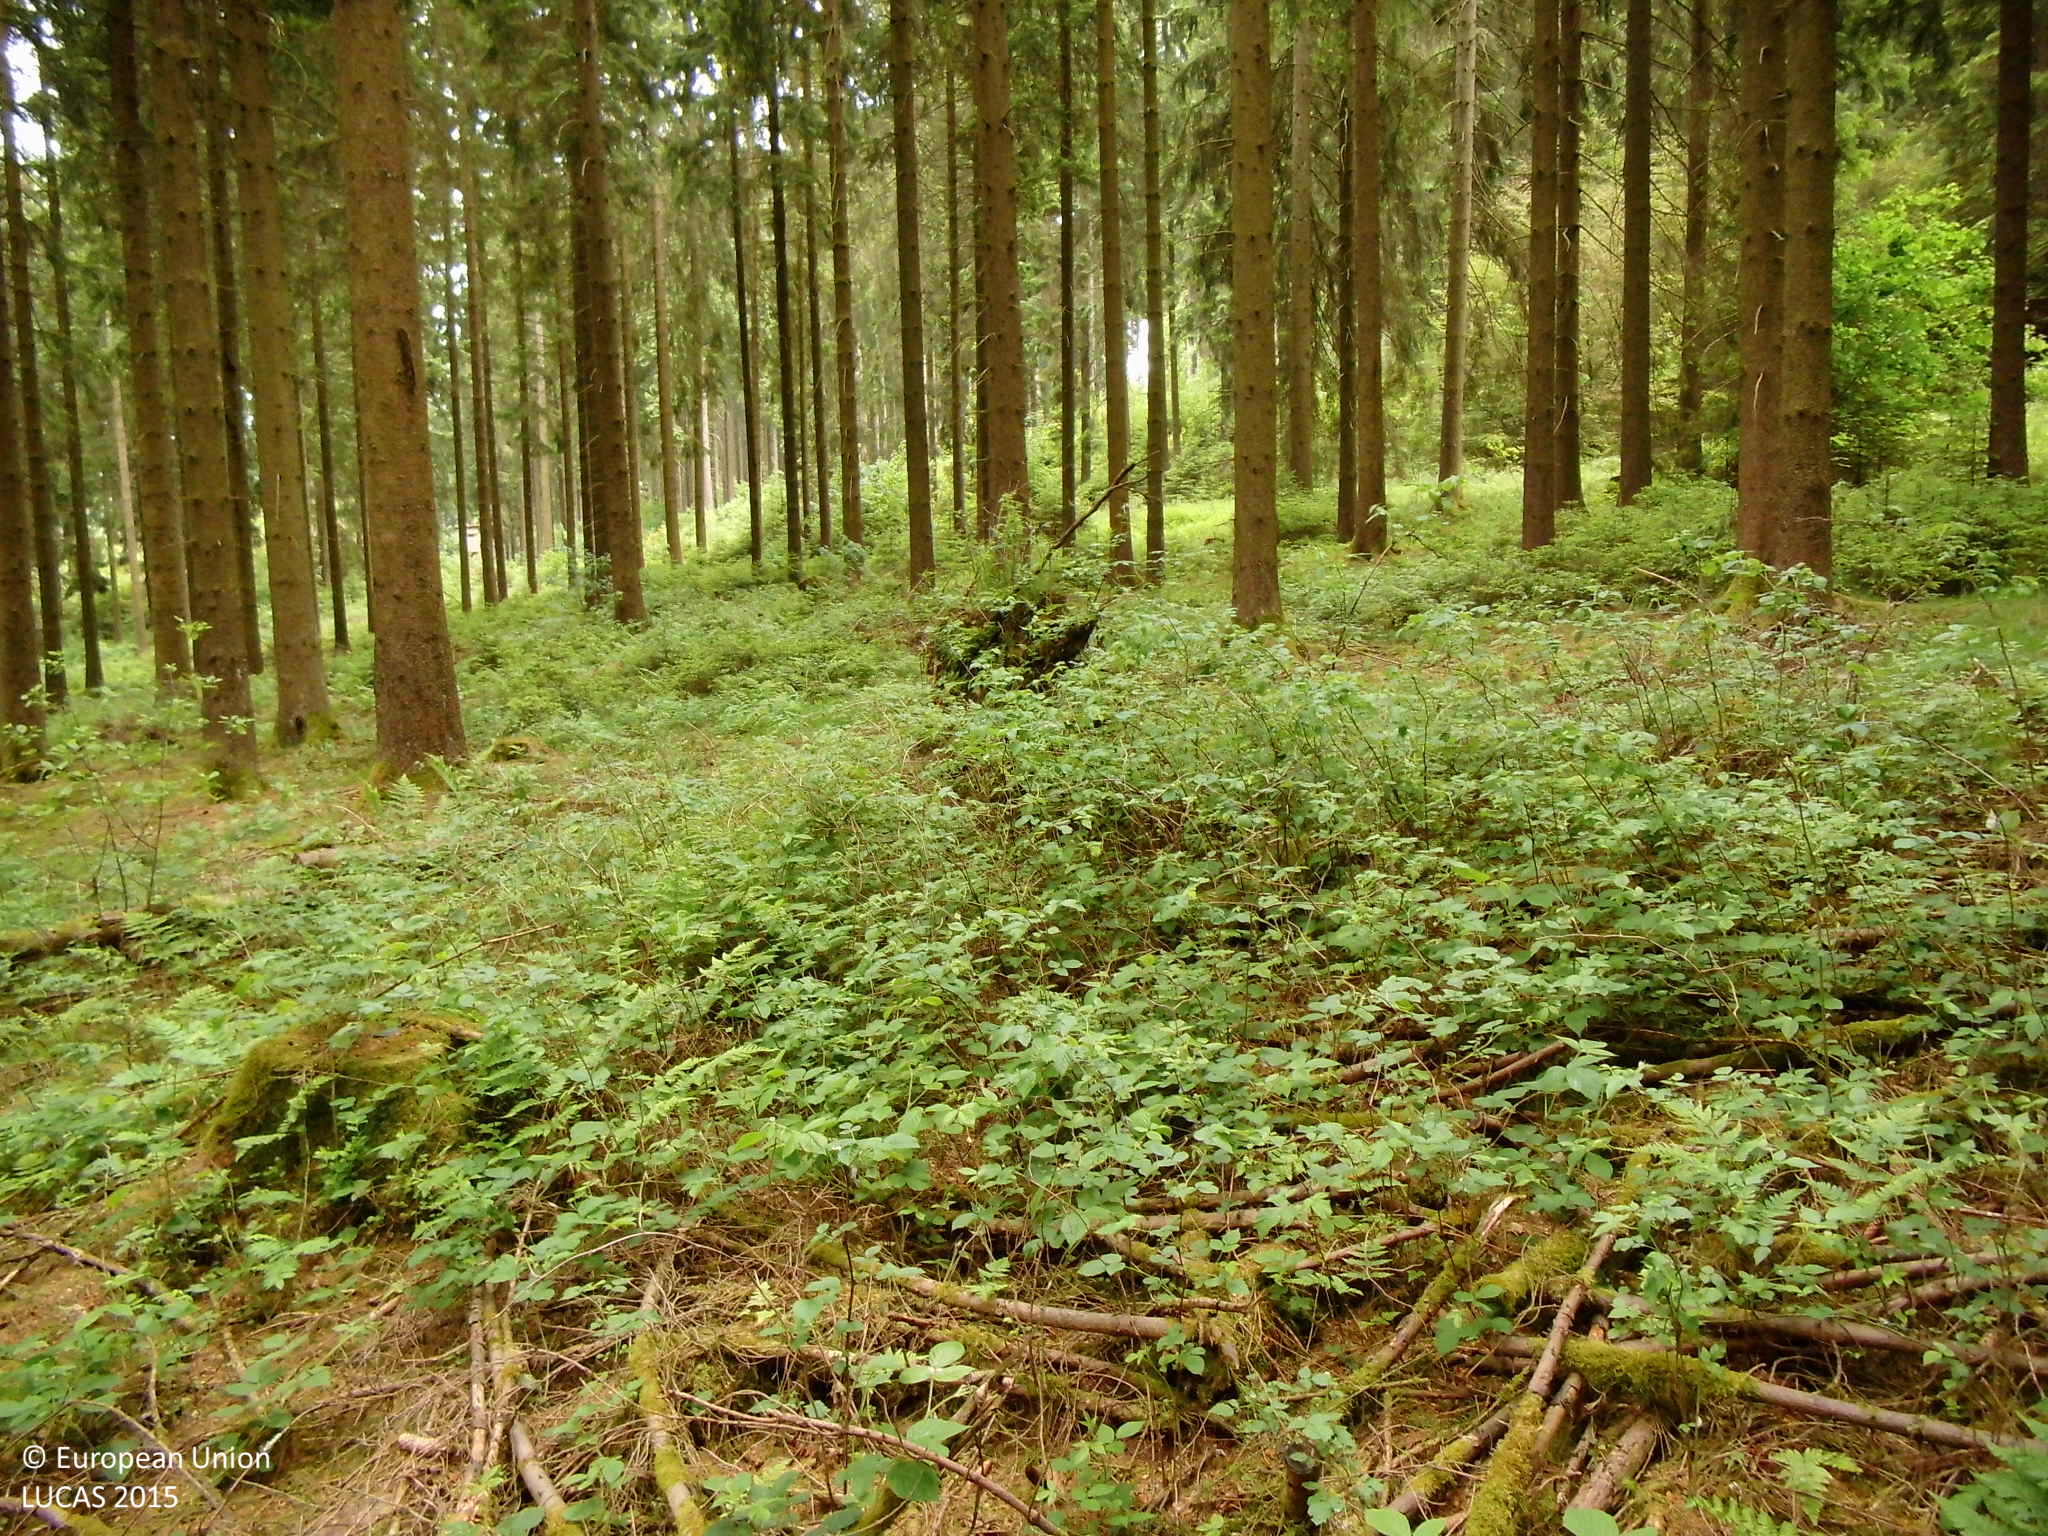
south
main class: Woodland
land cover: Spruce dominated coniferous woodland
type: hemiboreal forest and nemoral coniferous forest and mixed broadleaved-coniferous forest
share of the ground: > 75 %
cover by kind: coniferous forest trees 75 %, shrubs 10 %, lichens and mosses 10 %, herbaceous plants 5 %
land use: Forestry
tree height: > 5 m
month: June
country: DE
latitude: 51.0488
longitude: 8.0461
